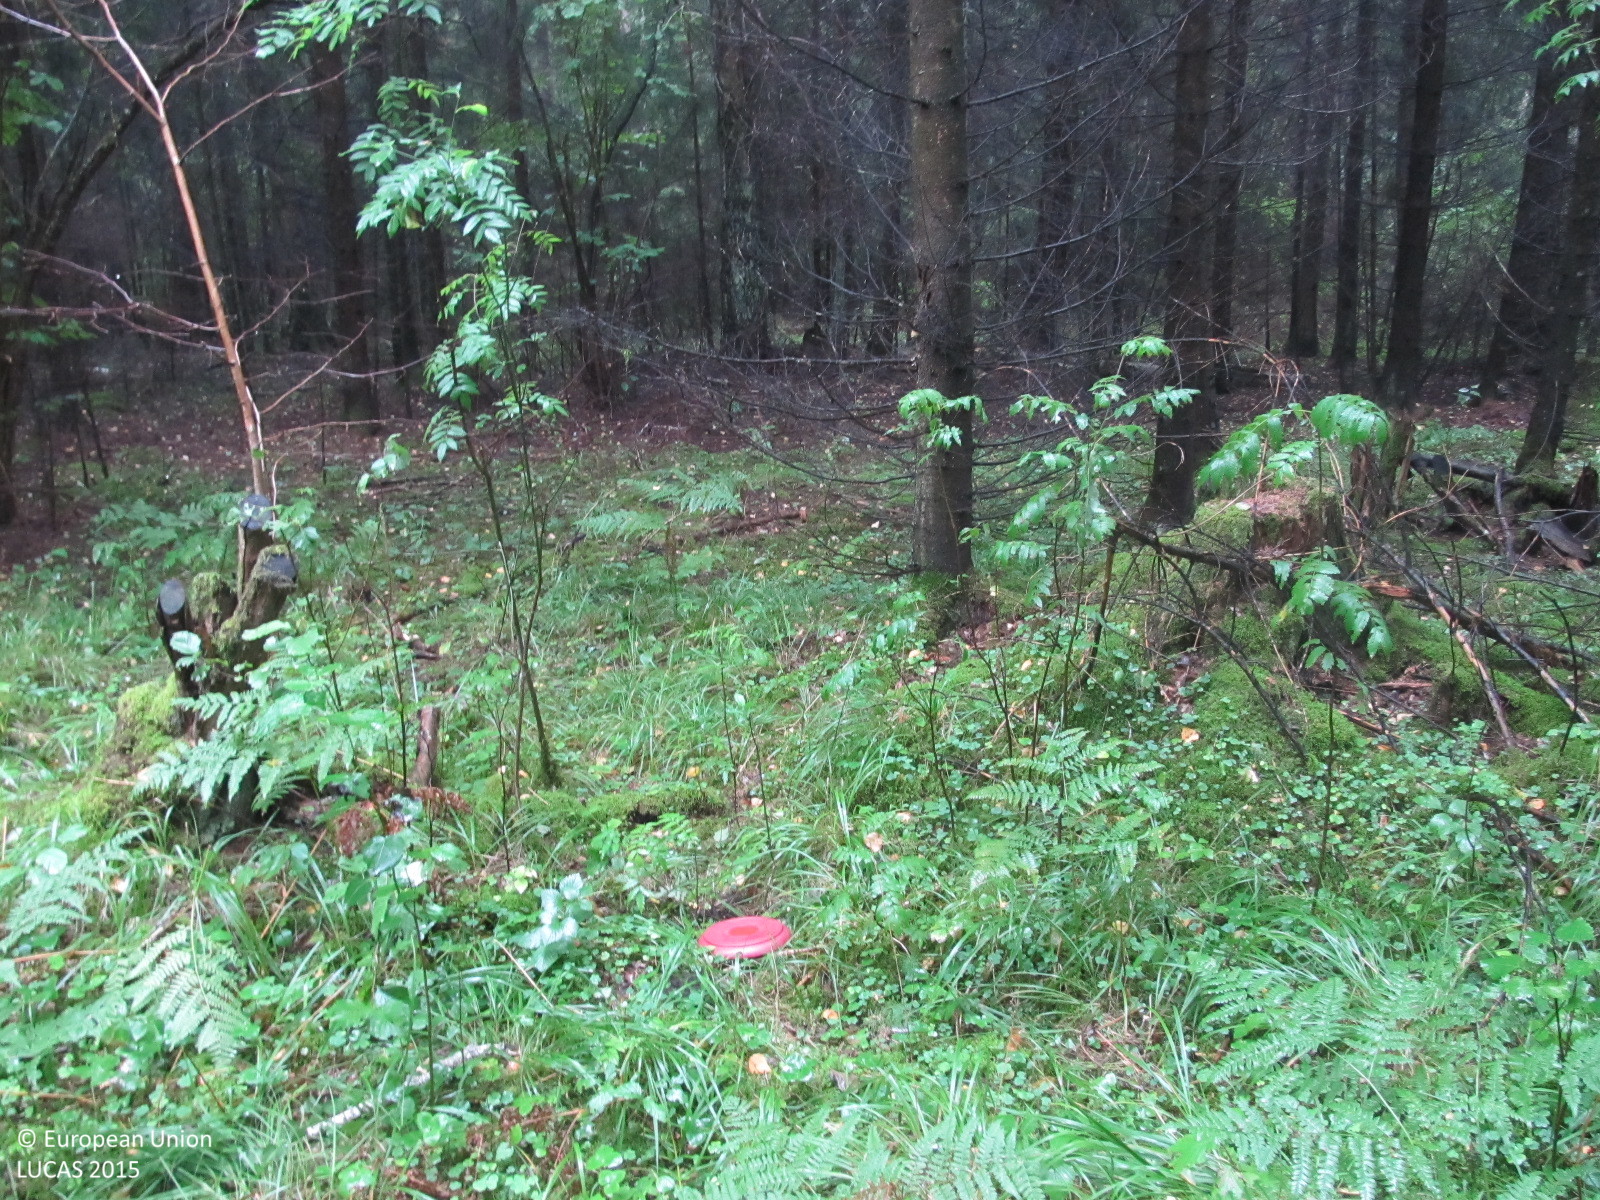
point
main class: Woodland
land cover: Spruce dominated mixed woodland
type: hemiboreal forest and nemoral coniferous forest and mixed broadleaved-coniferous forest
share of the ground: > 75 %
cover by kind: coniferous forest trees 65 %, broadleaved forest trees 30 %, herbaceous plants 5 %
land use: Forestry
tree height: > 5 m
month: September
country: LT
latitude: 56.0538
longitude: 23.1570
